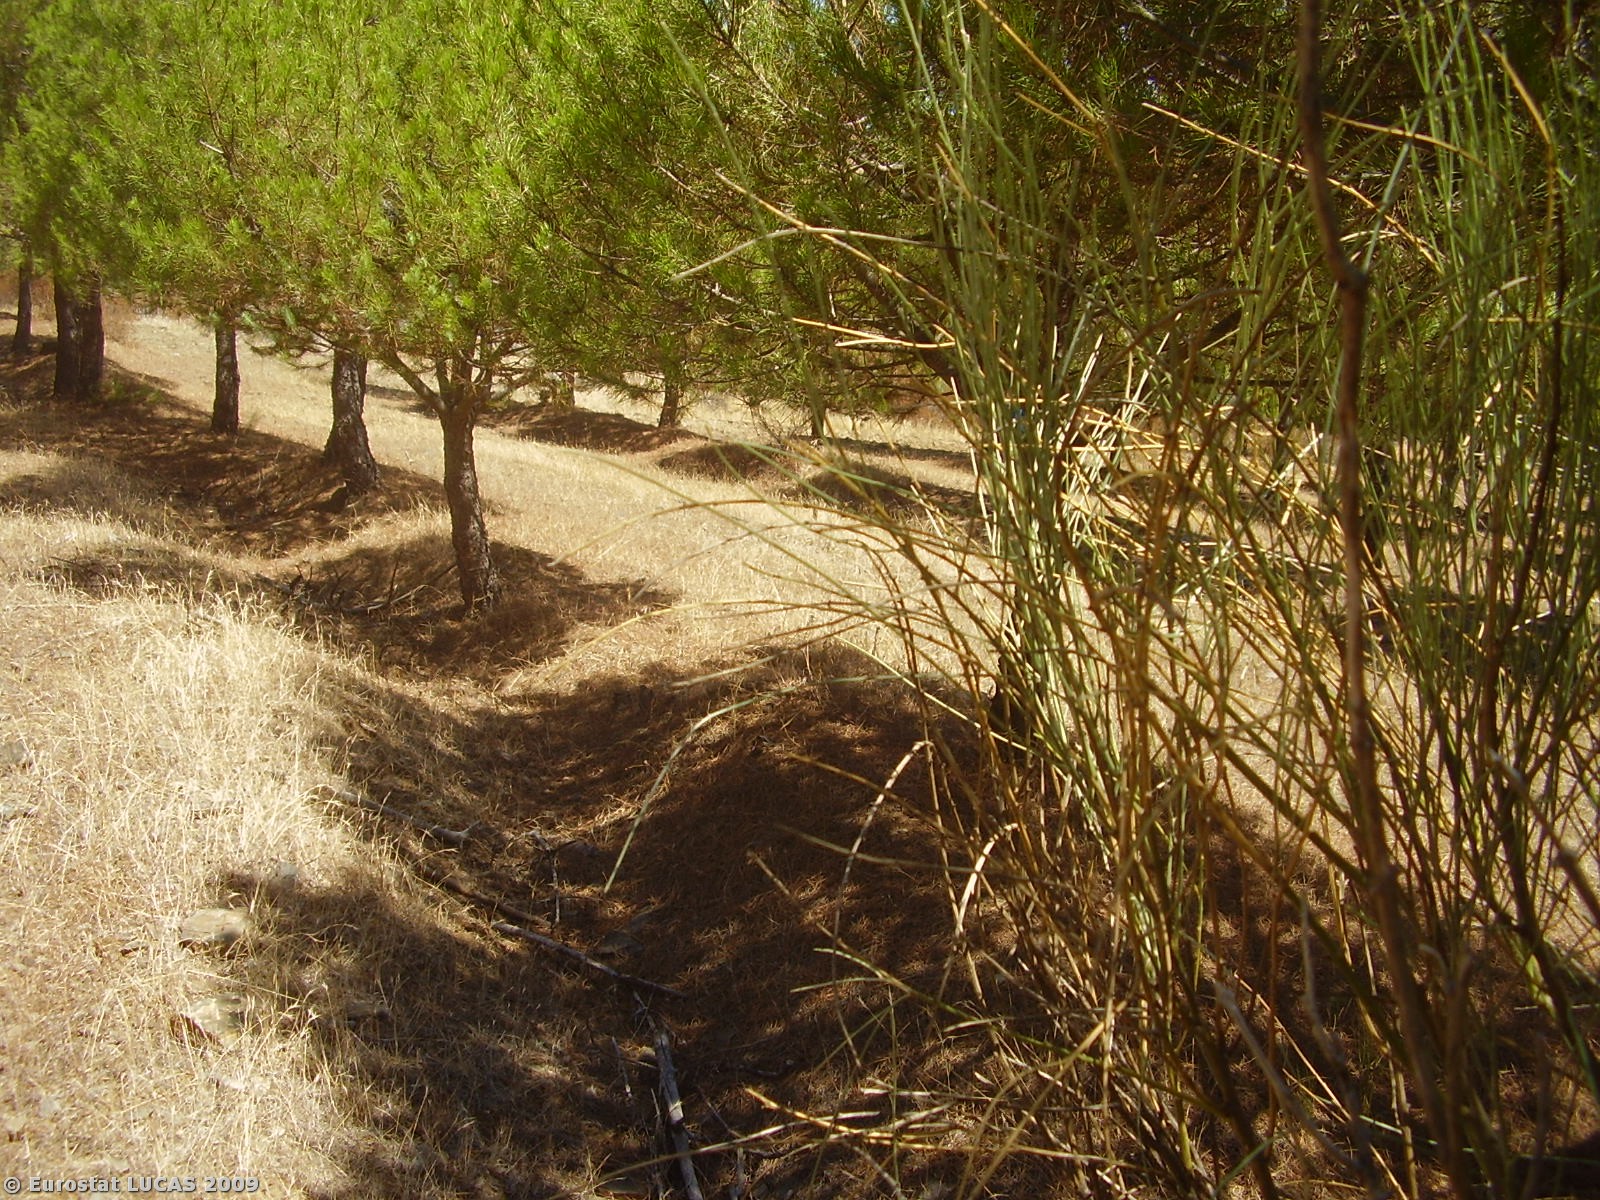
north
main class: Woodland
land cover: Coniferous woodland
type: coniferous forest of the mediterranean region
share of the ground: 10 - 25 %
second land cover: Spontaneously vegetated surfaces
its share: > 75 %
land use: Forestry
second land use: Fallow land
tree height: > 5 m
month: August
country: PT
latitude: 37.9247
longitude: -7.6893
